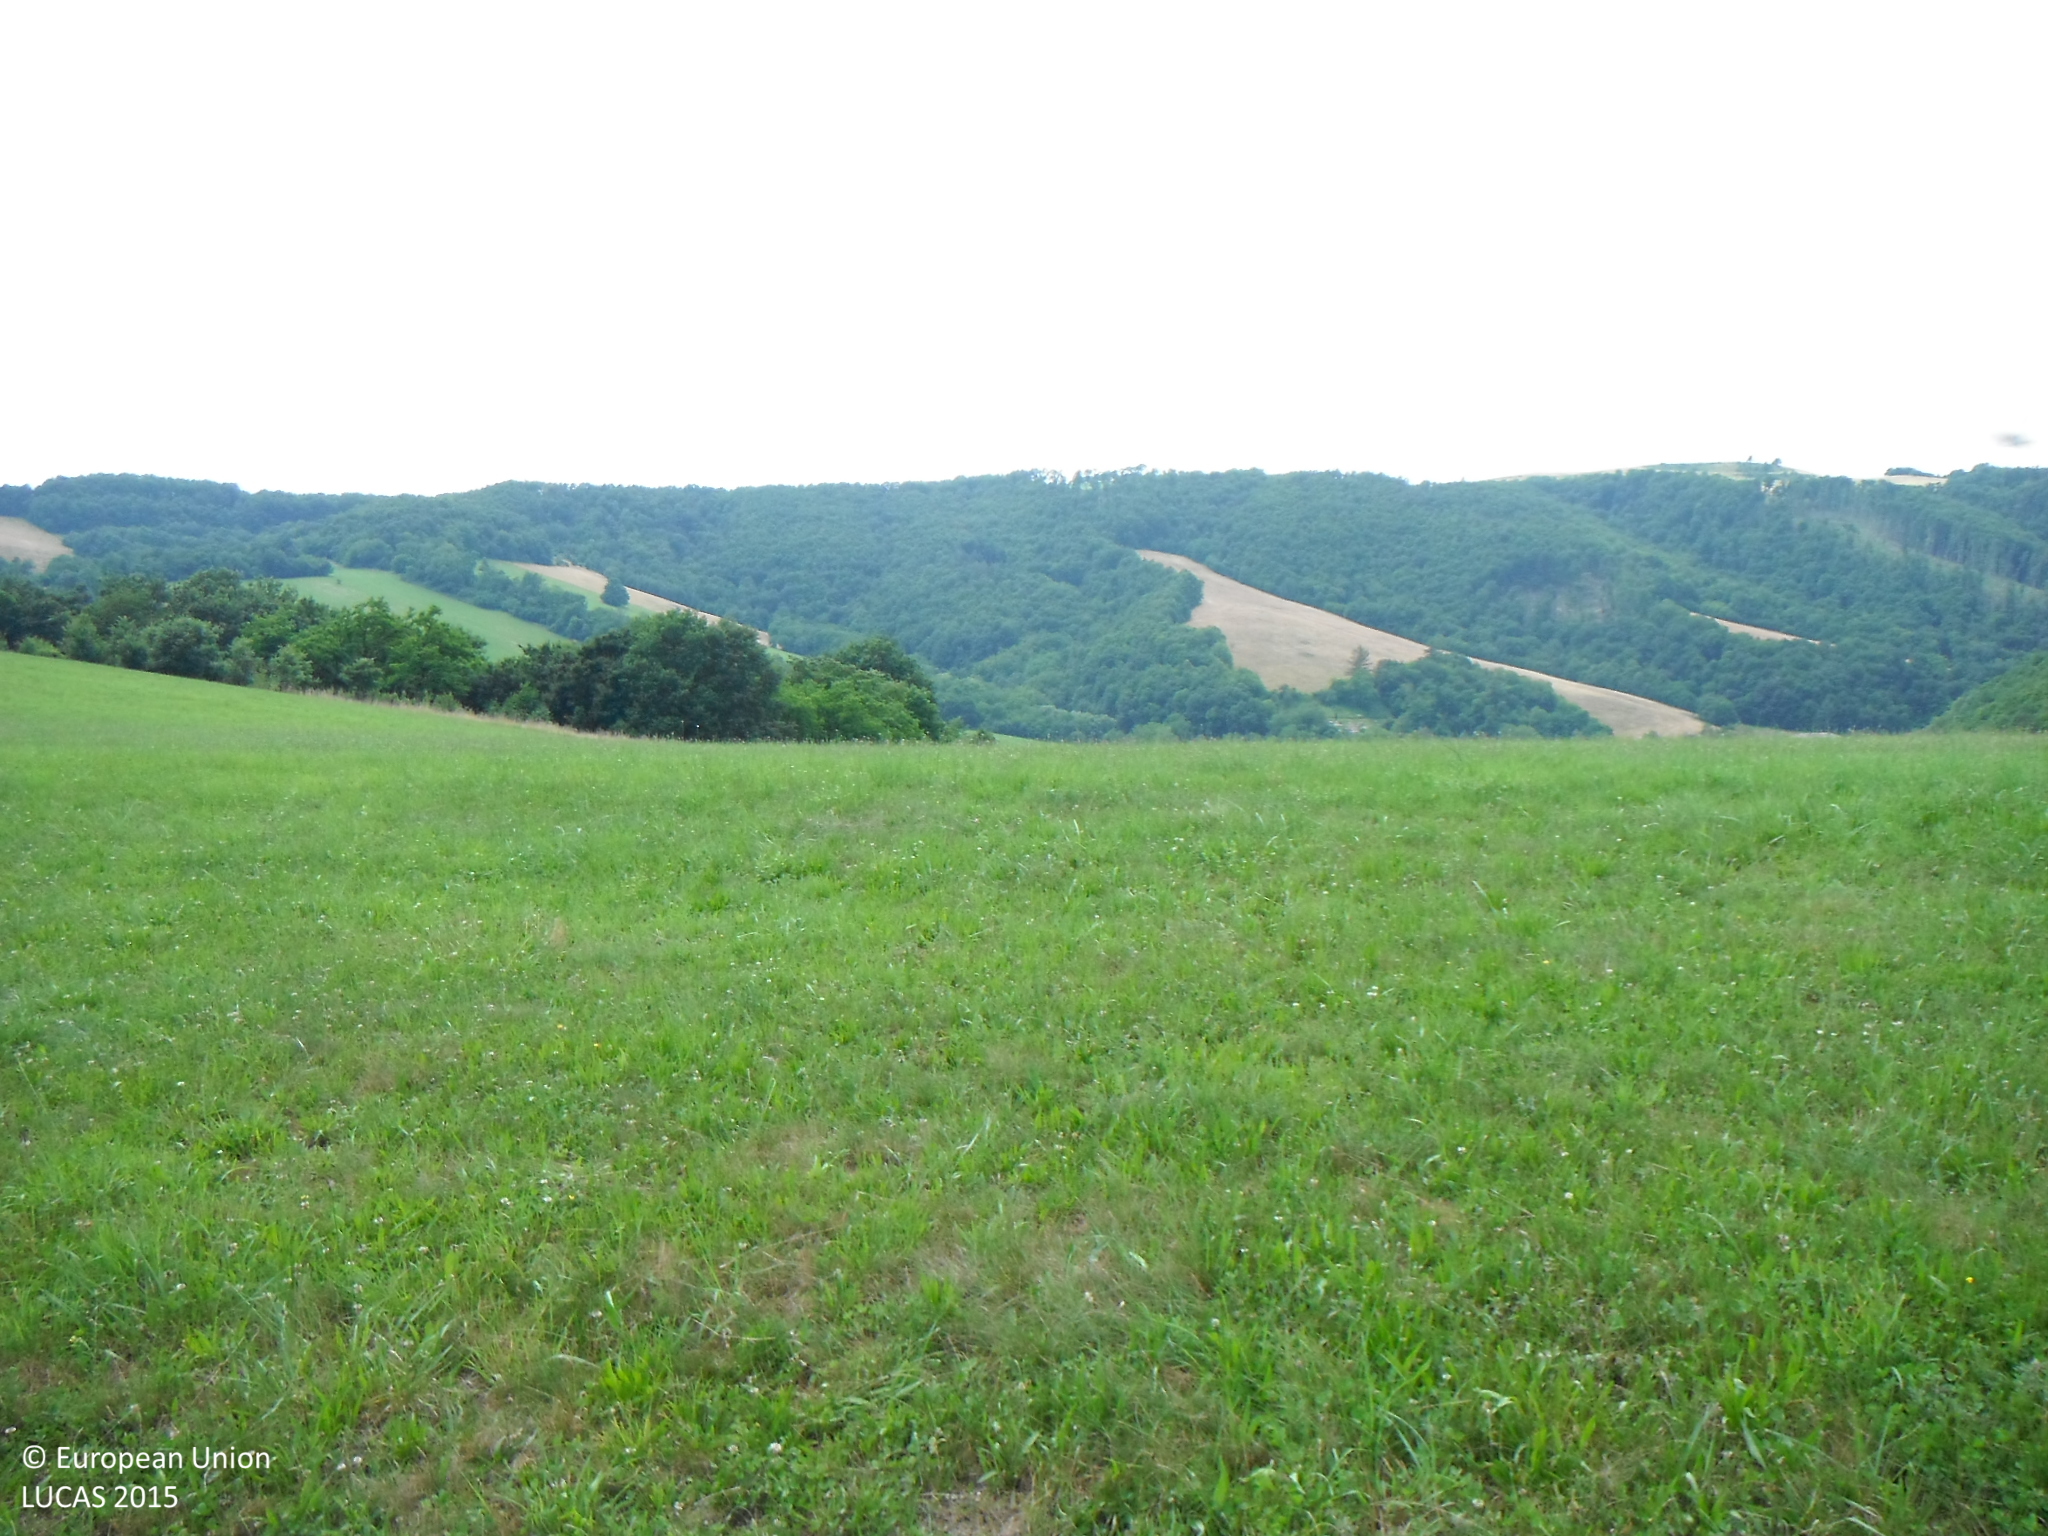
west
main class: Grassland
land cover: Grassland without tree/shrub cover
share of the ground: > 75 %
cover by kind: herbaceous plants 100 %
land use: Agriculture (excluding fallow land and kitchen gardens)
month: June
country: SK
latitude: 48.5259
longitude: 20.0365
